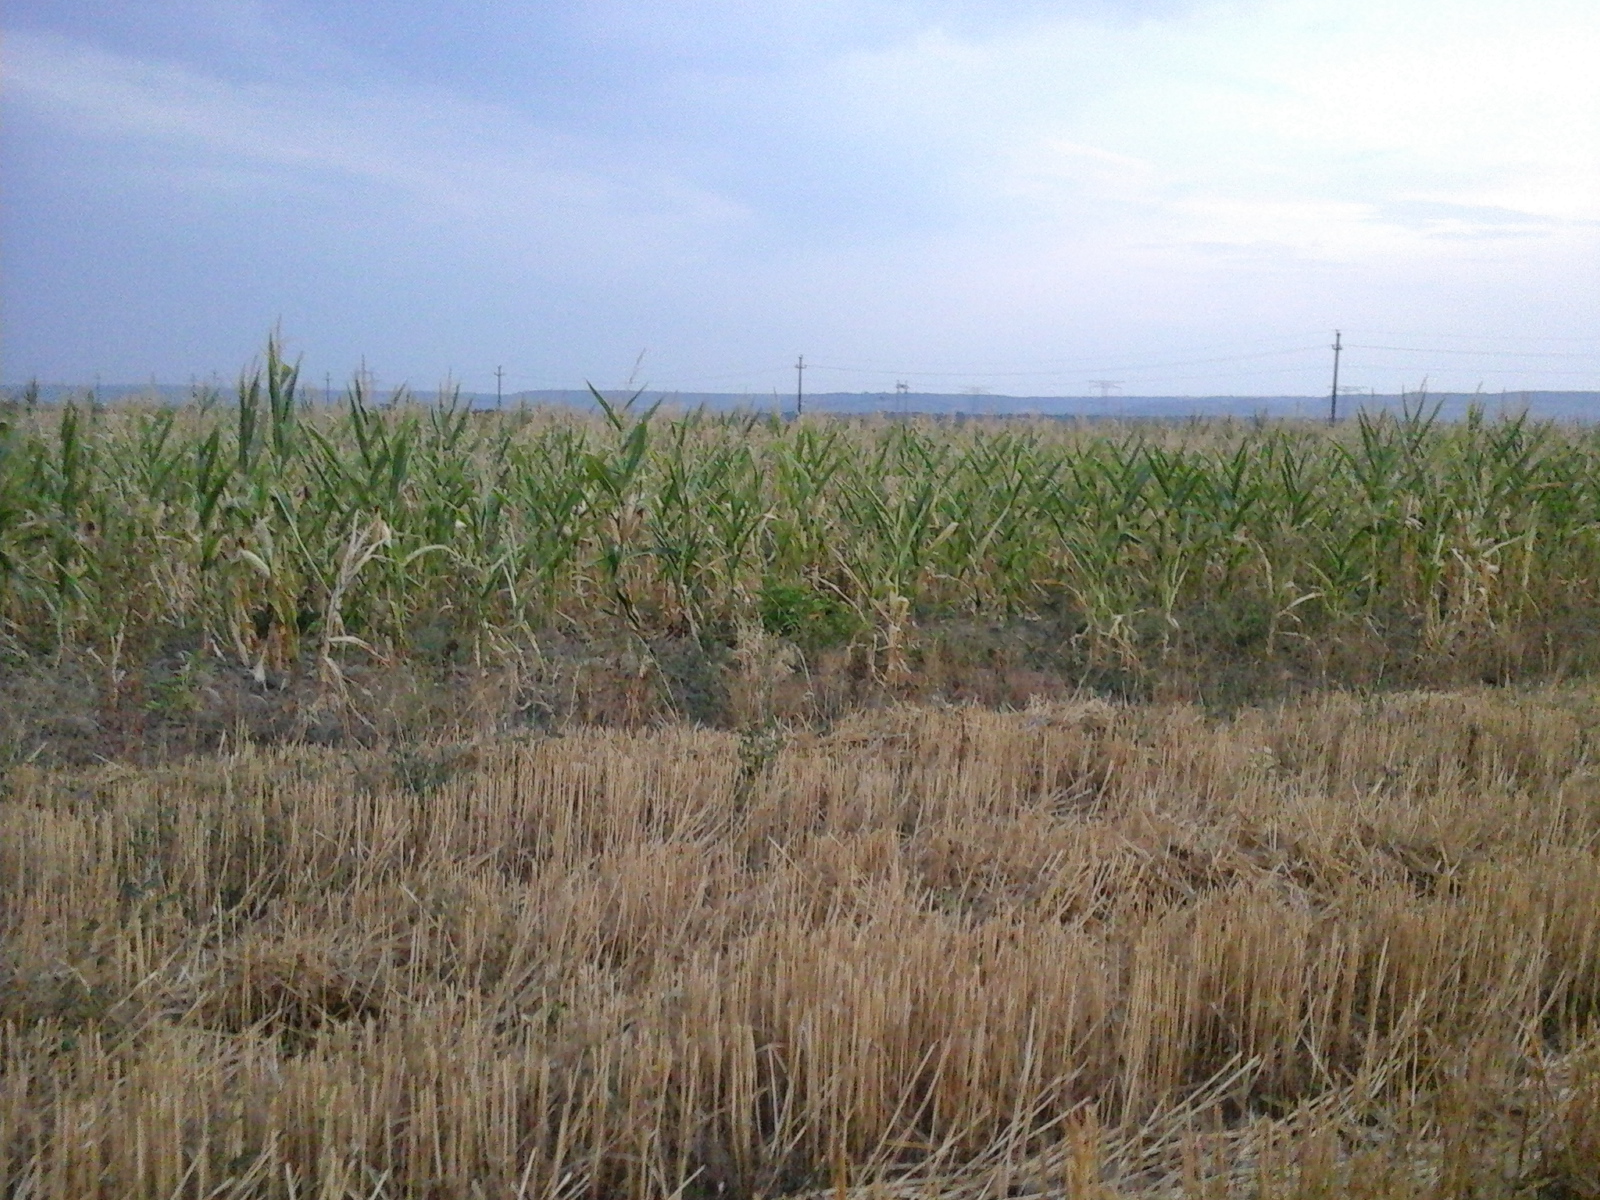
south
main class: Cropland
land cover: Common wheat
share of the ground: > 75 %
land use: Agriculture (excluding fallow land and kitchen gardens)
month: August
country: RO
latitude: 44.5789
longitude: 23.4916
